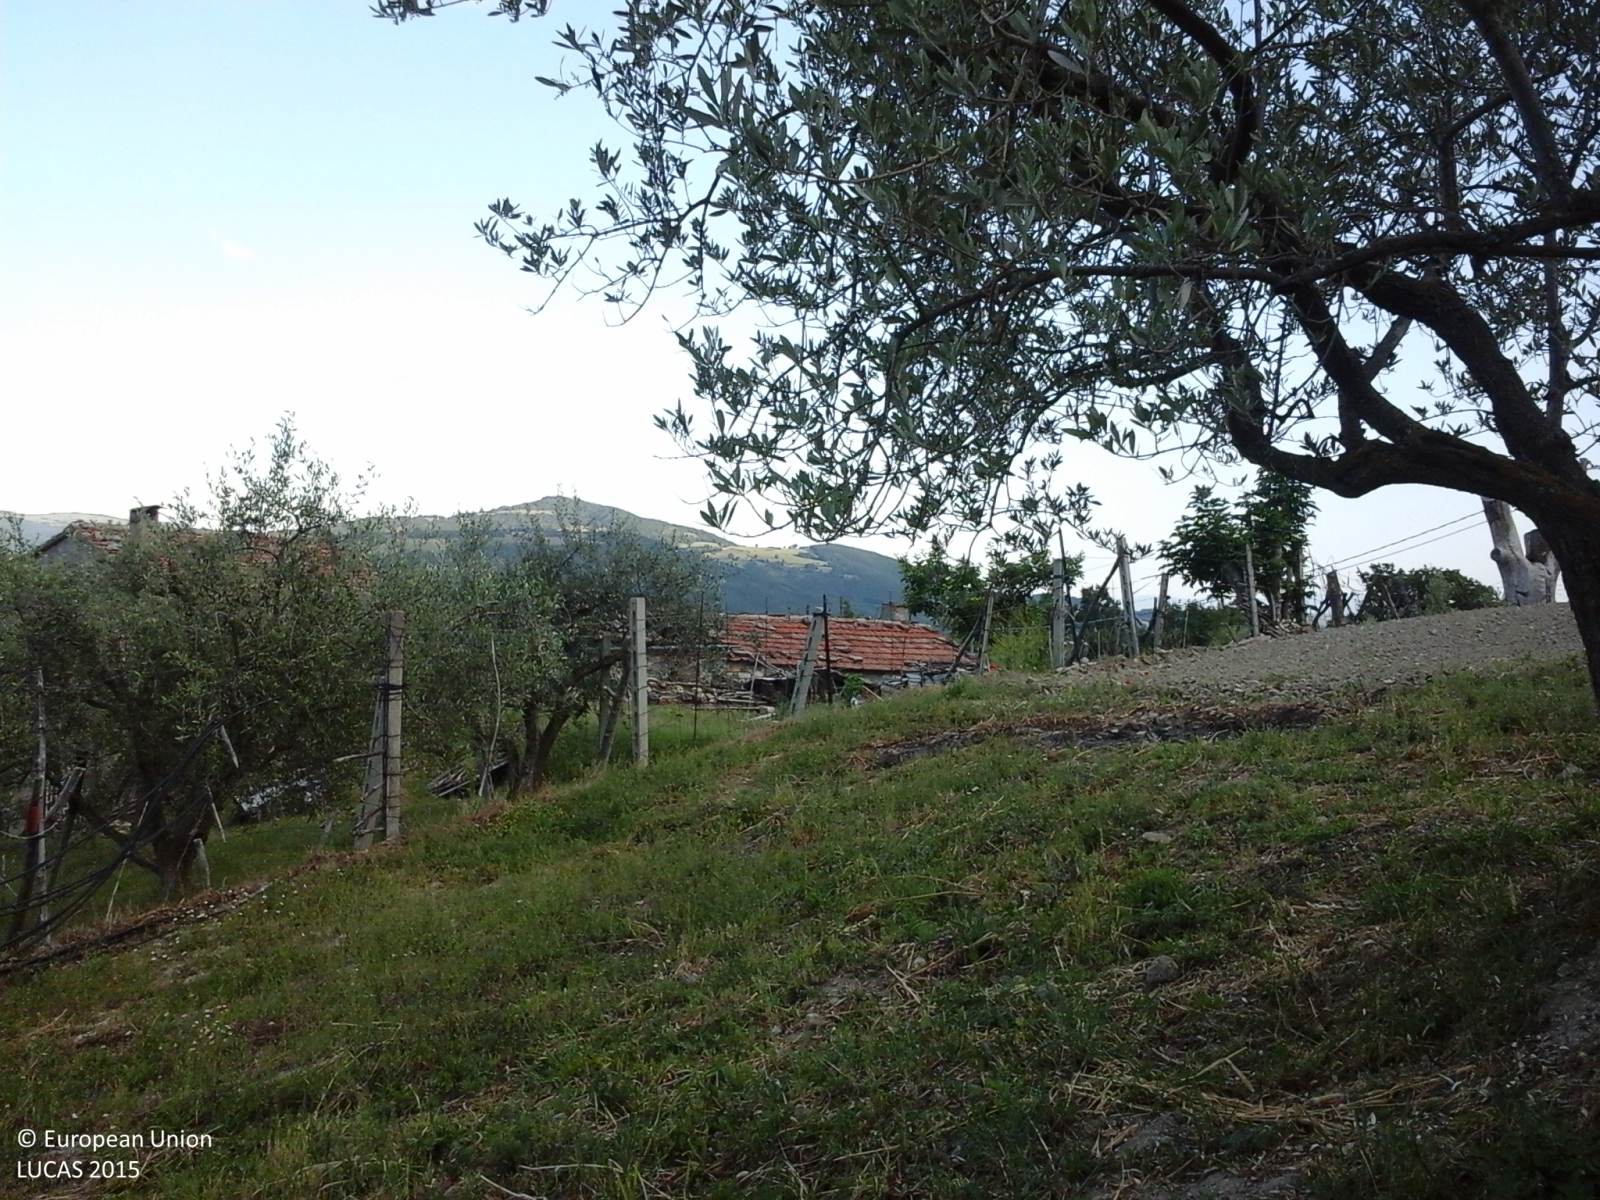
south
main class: Cropland
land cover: Olive groves
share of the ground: 25 - 50 %
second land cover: Spontaneously vegetated surfaces
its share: 25 - 50 %
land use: Agriculture (excluding fallow land and kitchen gardens)
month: June
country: IT
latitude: 41.7943
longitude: 14.4977
